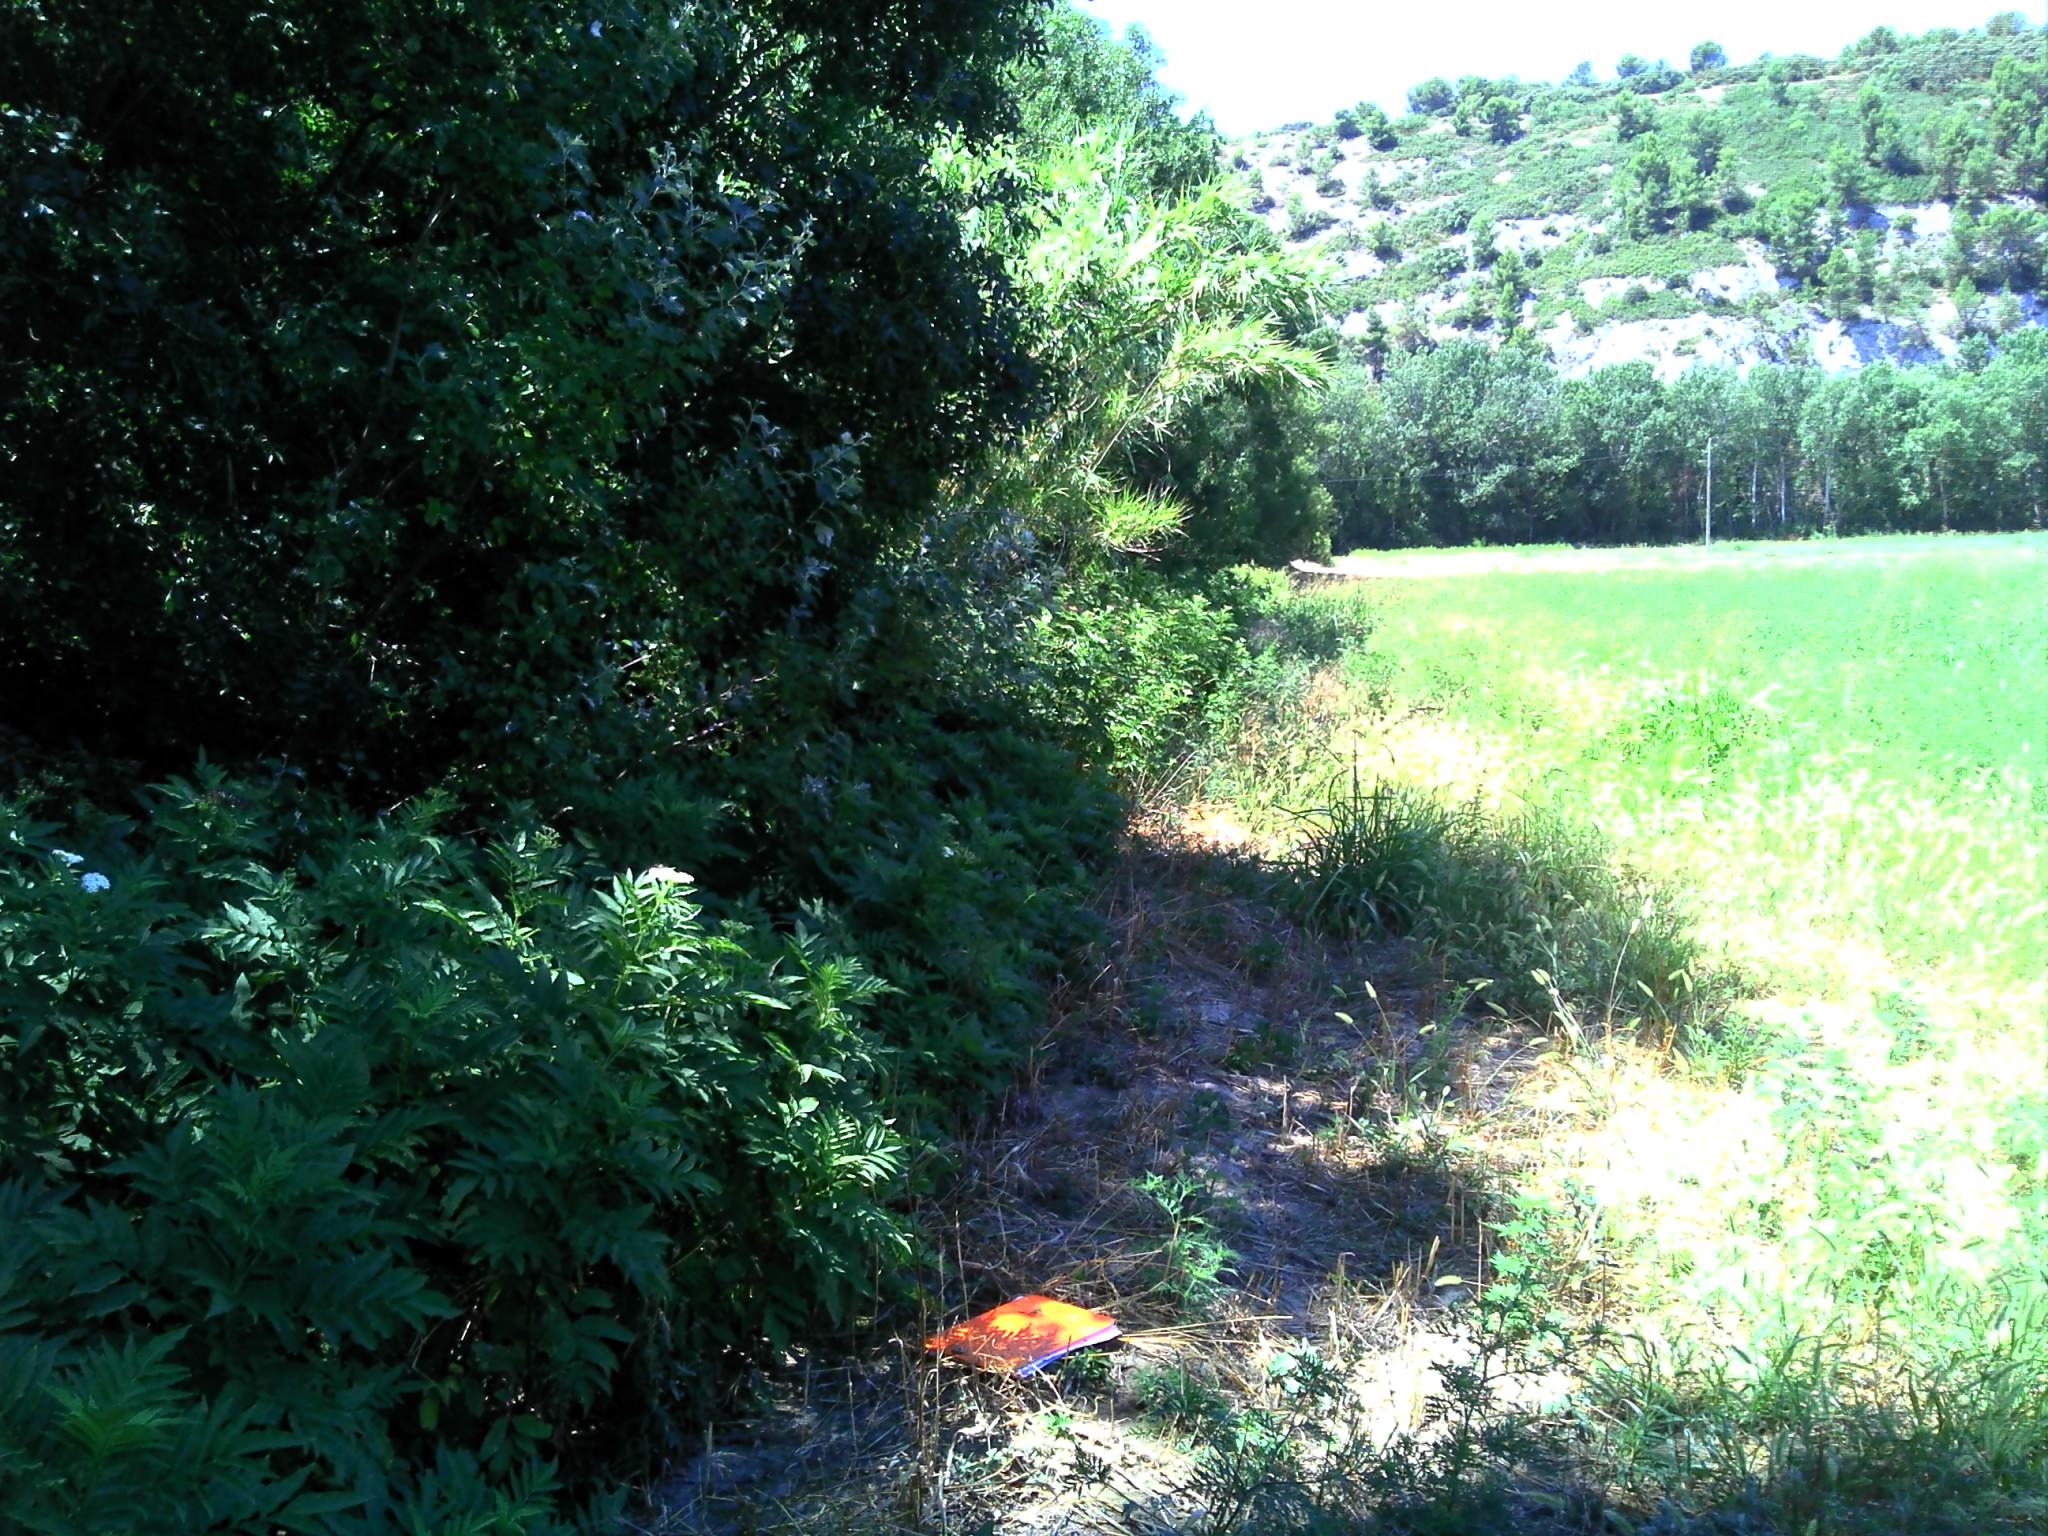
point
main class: Grassland
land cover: Spontaneously vegetated surfaces
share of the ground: > 75 %
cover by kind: herbaceous plants 100 %
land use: Fallow land
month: August
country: FR
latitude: 43.9857
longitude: 4.8093
